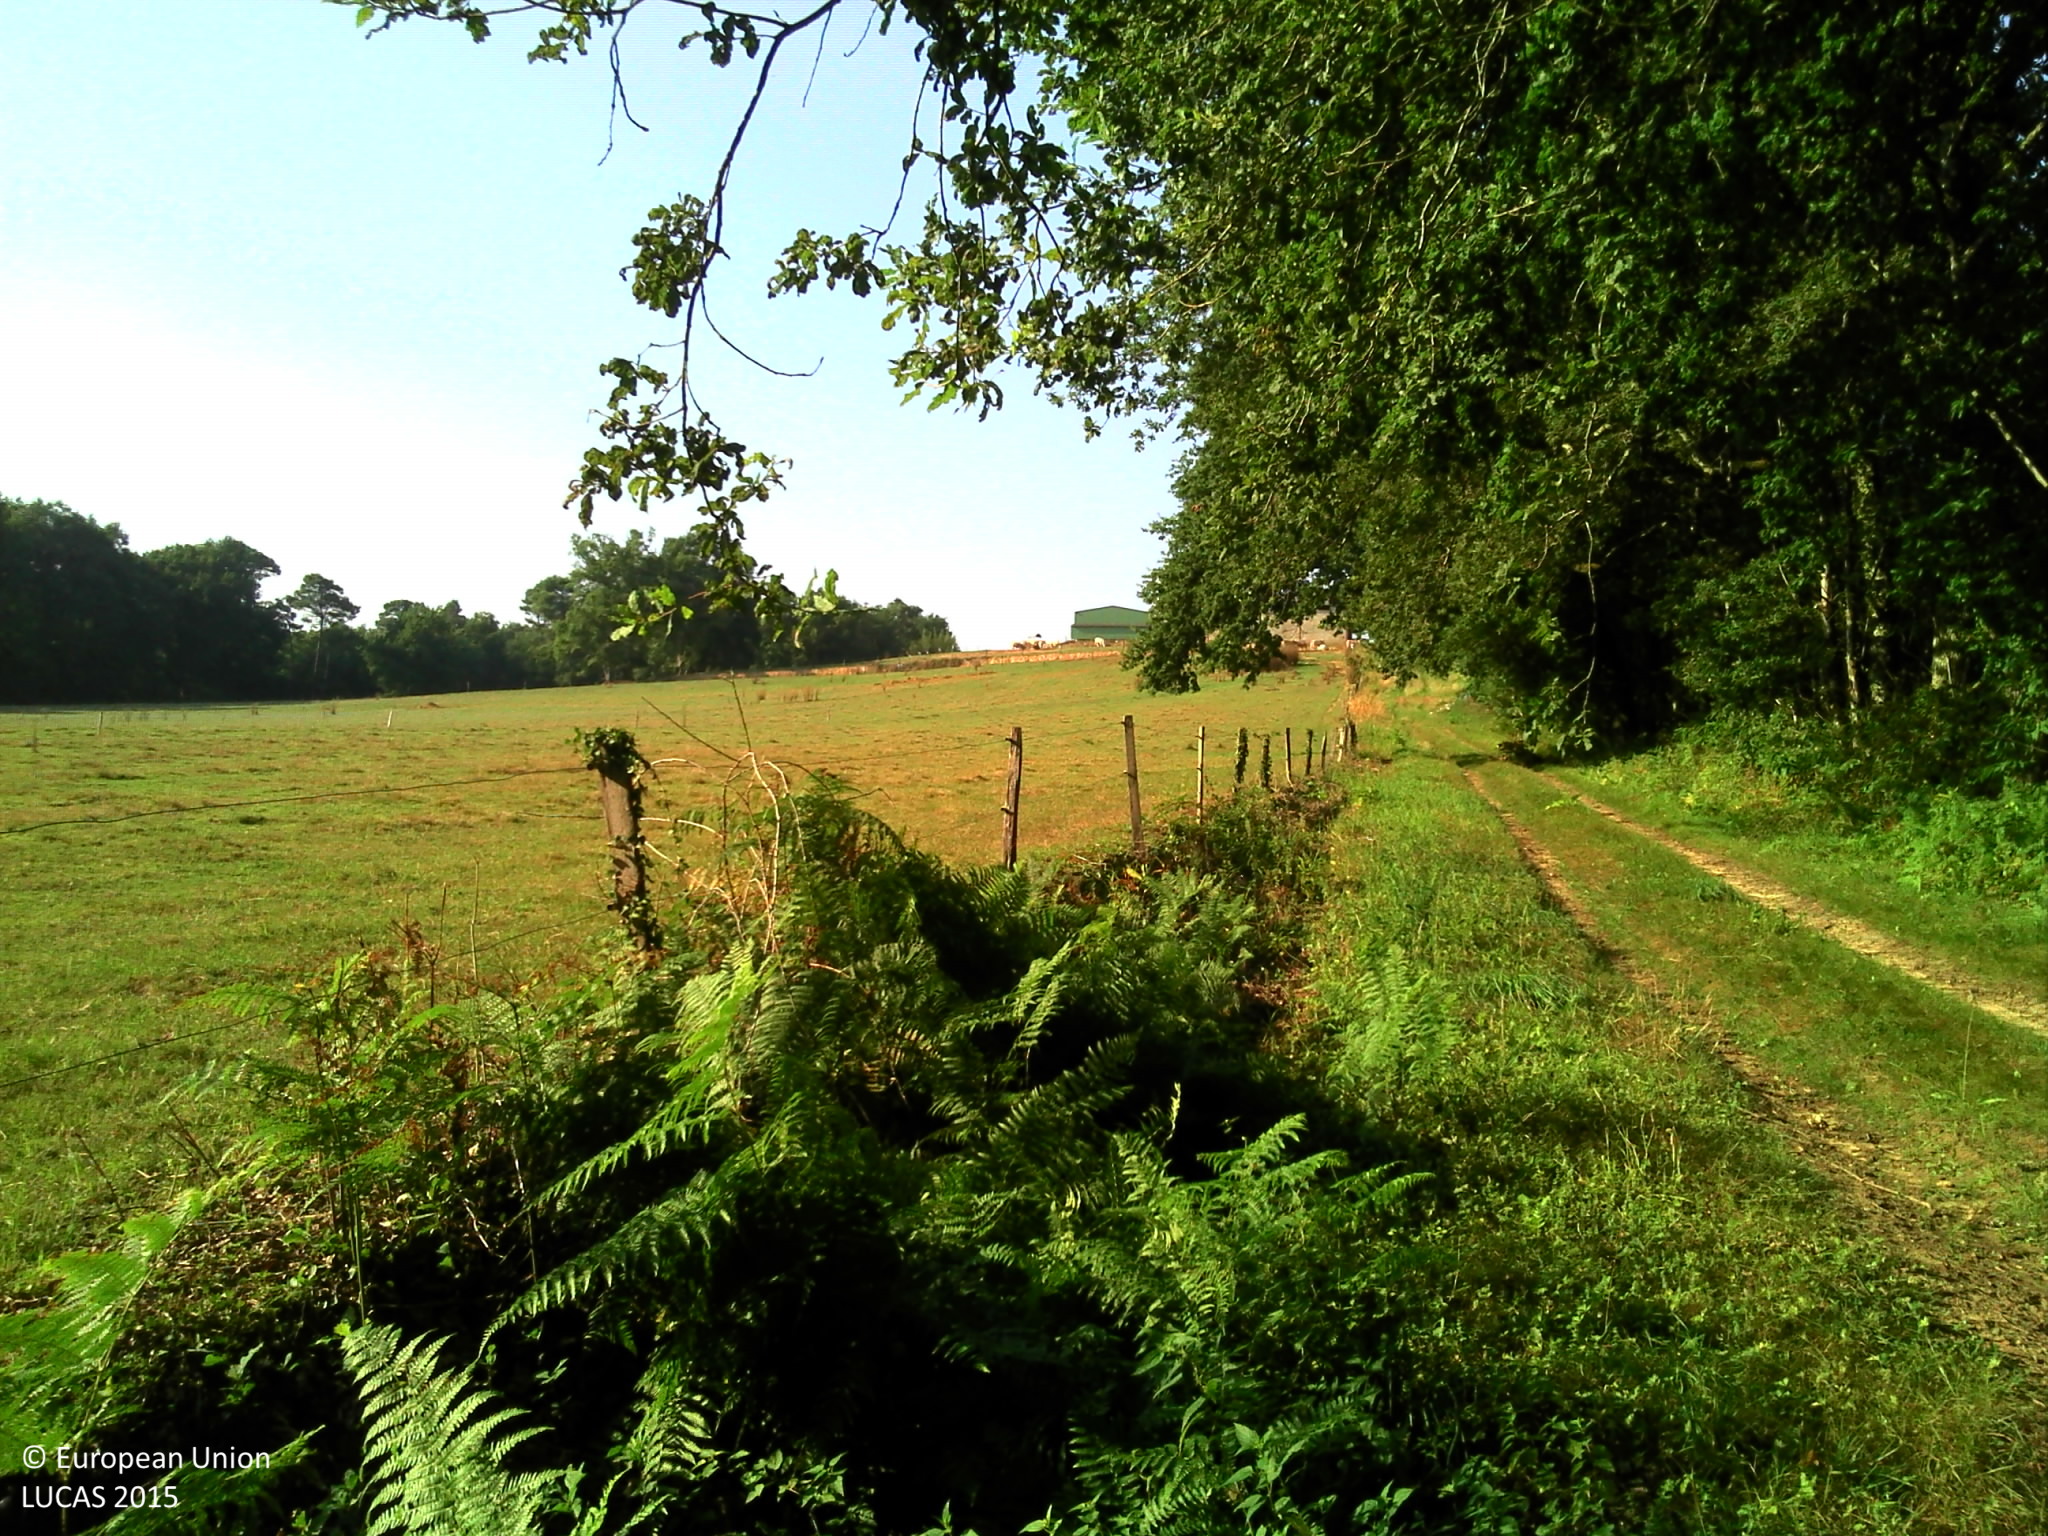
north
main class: Woodland
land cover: Broadleaved woodland
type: mesophytic deciduous forest
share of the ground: > 75 %
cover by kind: broadleaved forest trees 85 %, herbaceous plants 15 %
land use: Forestry
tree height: > 5 m
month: August
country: FR
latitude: 43.7483
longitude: -0.8053
